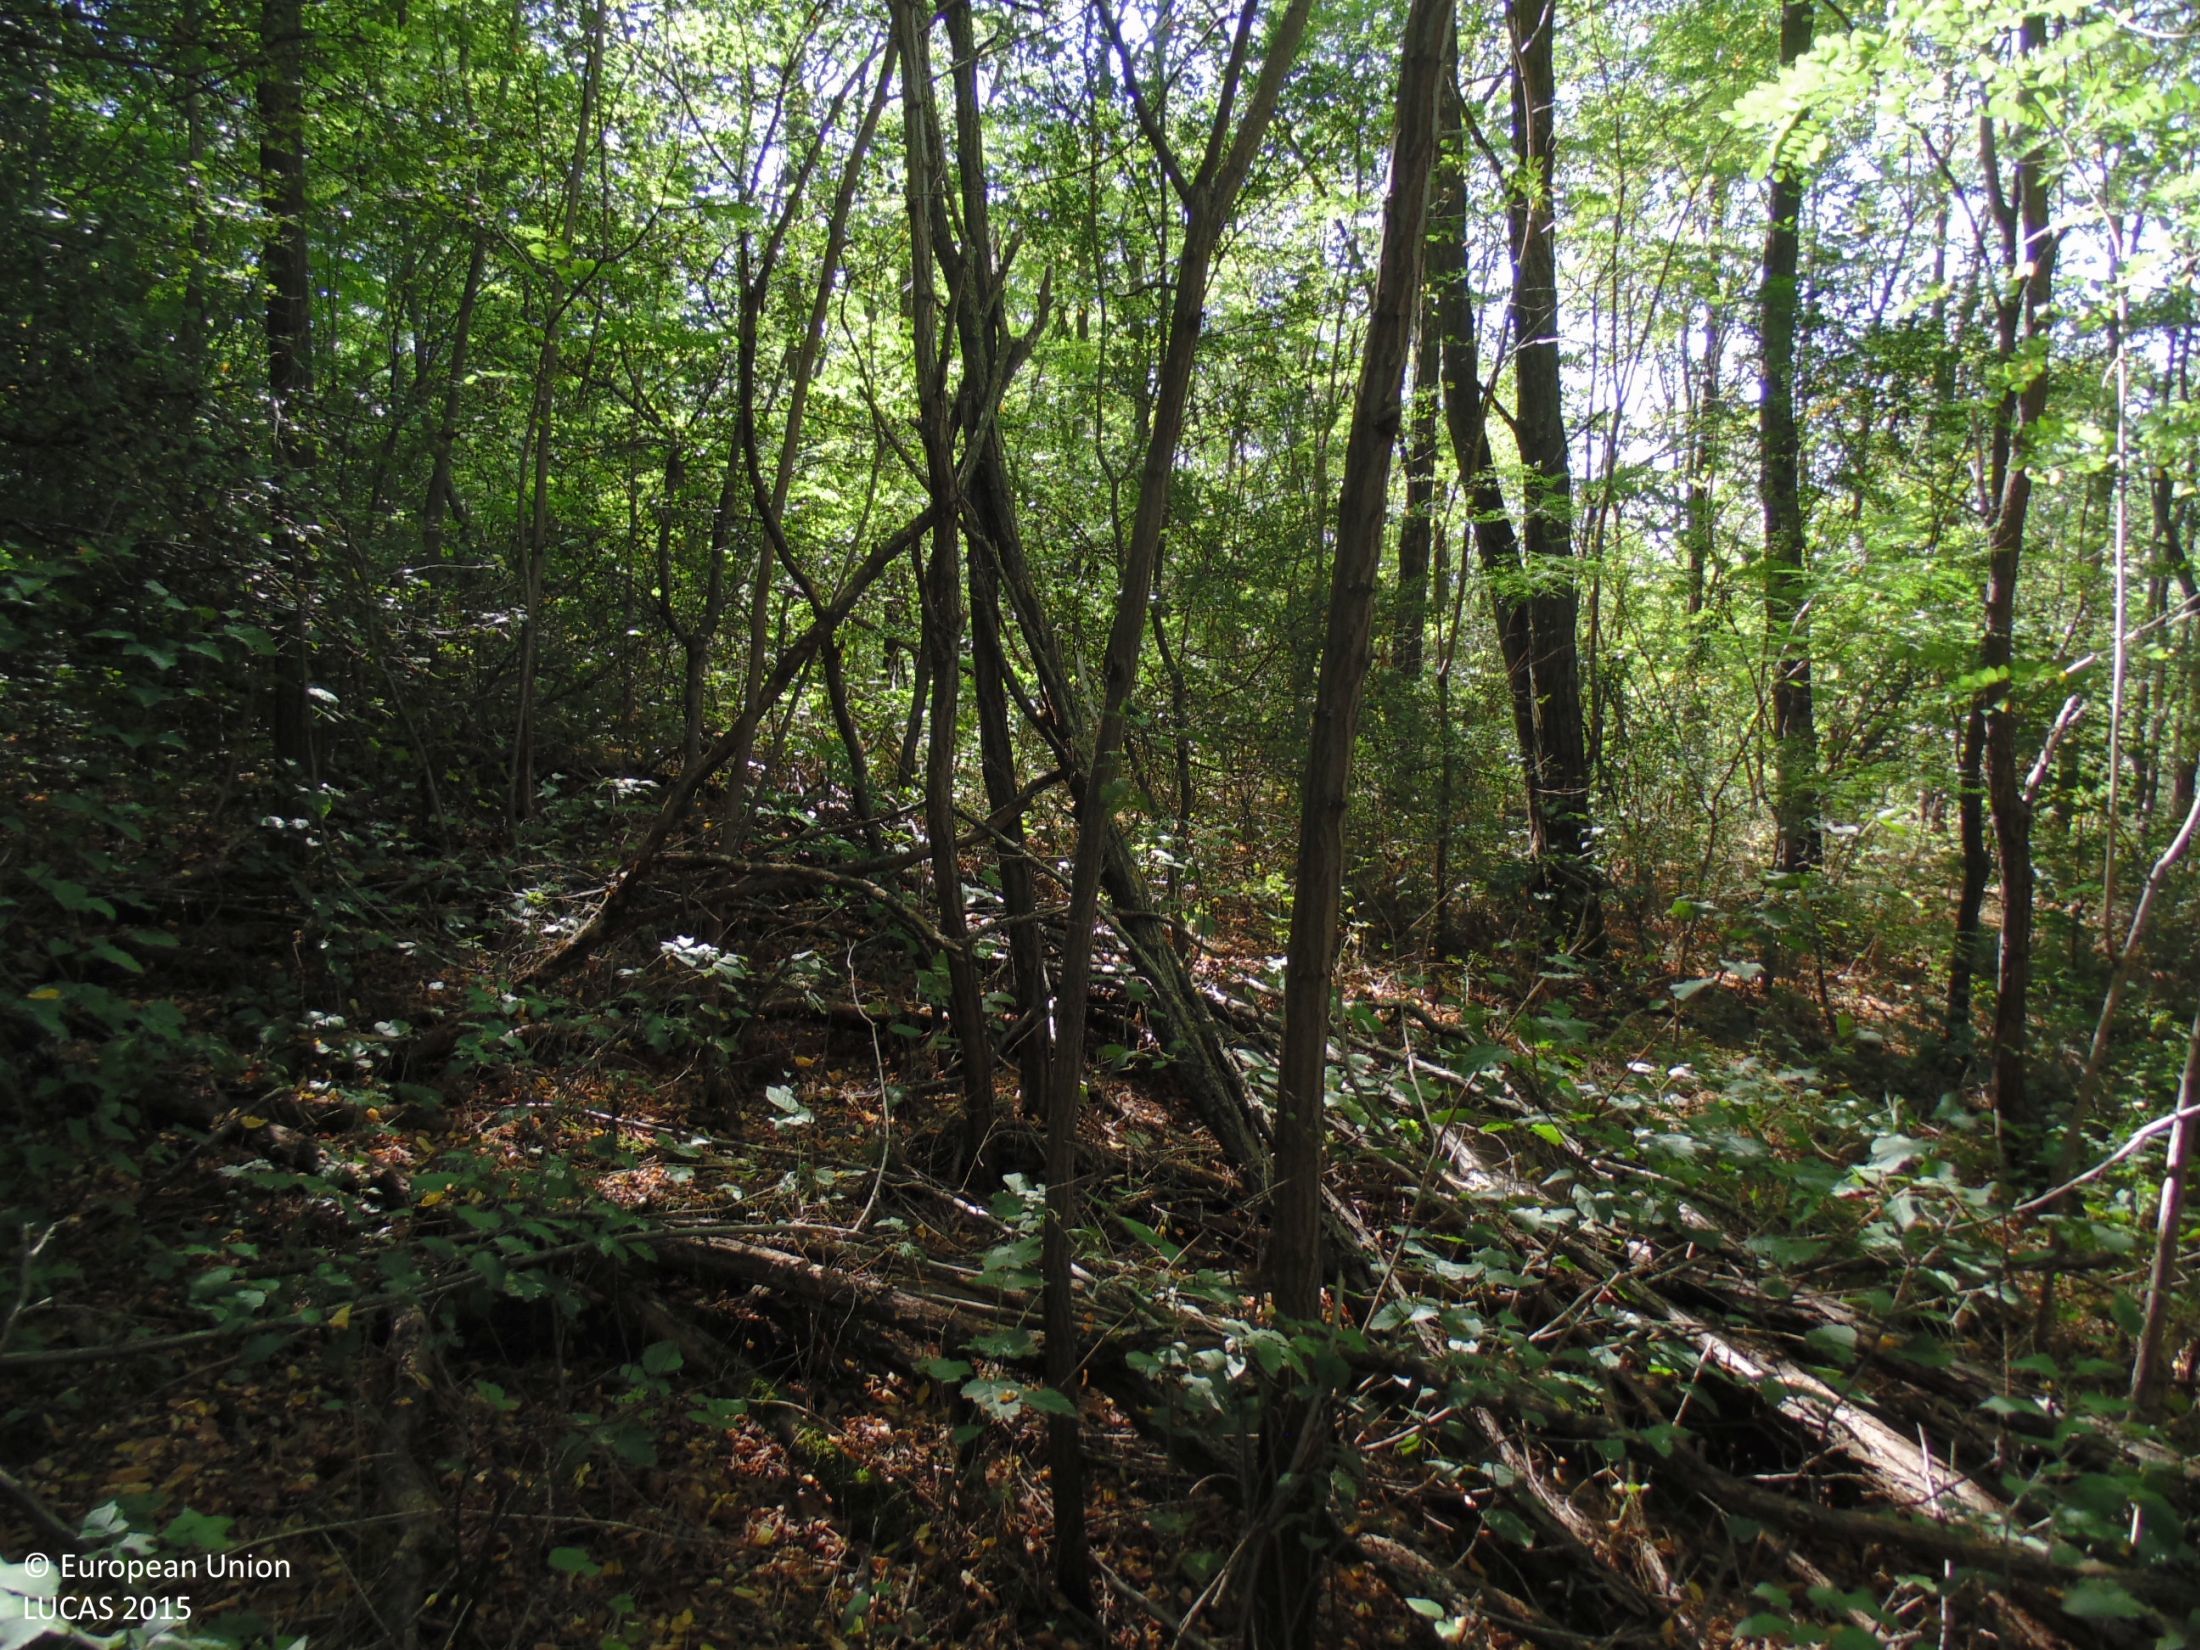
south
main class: Woodland
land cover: Broadleaved woodland
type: mesophytic deciduous forest
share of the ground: > 75 %
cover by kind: broadleaved forest trees 90 %, shrubs 5 %, herbaceous plants 5 %
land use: Forestry
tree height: > 5 m
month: September
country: BG
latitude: 44.0771
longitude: 26.9940
